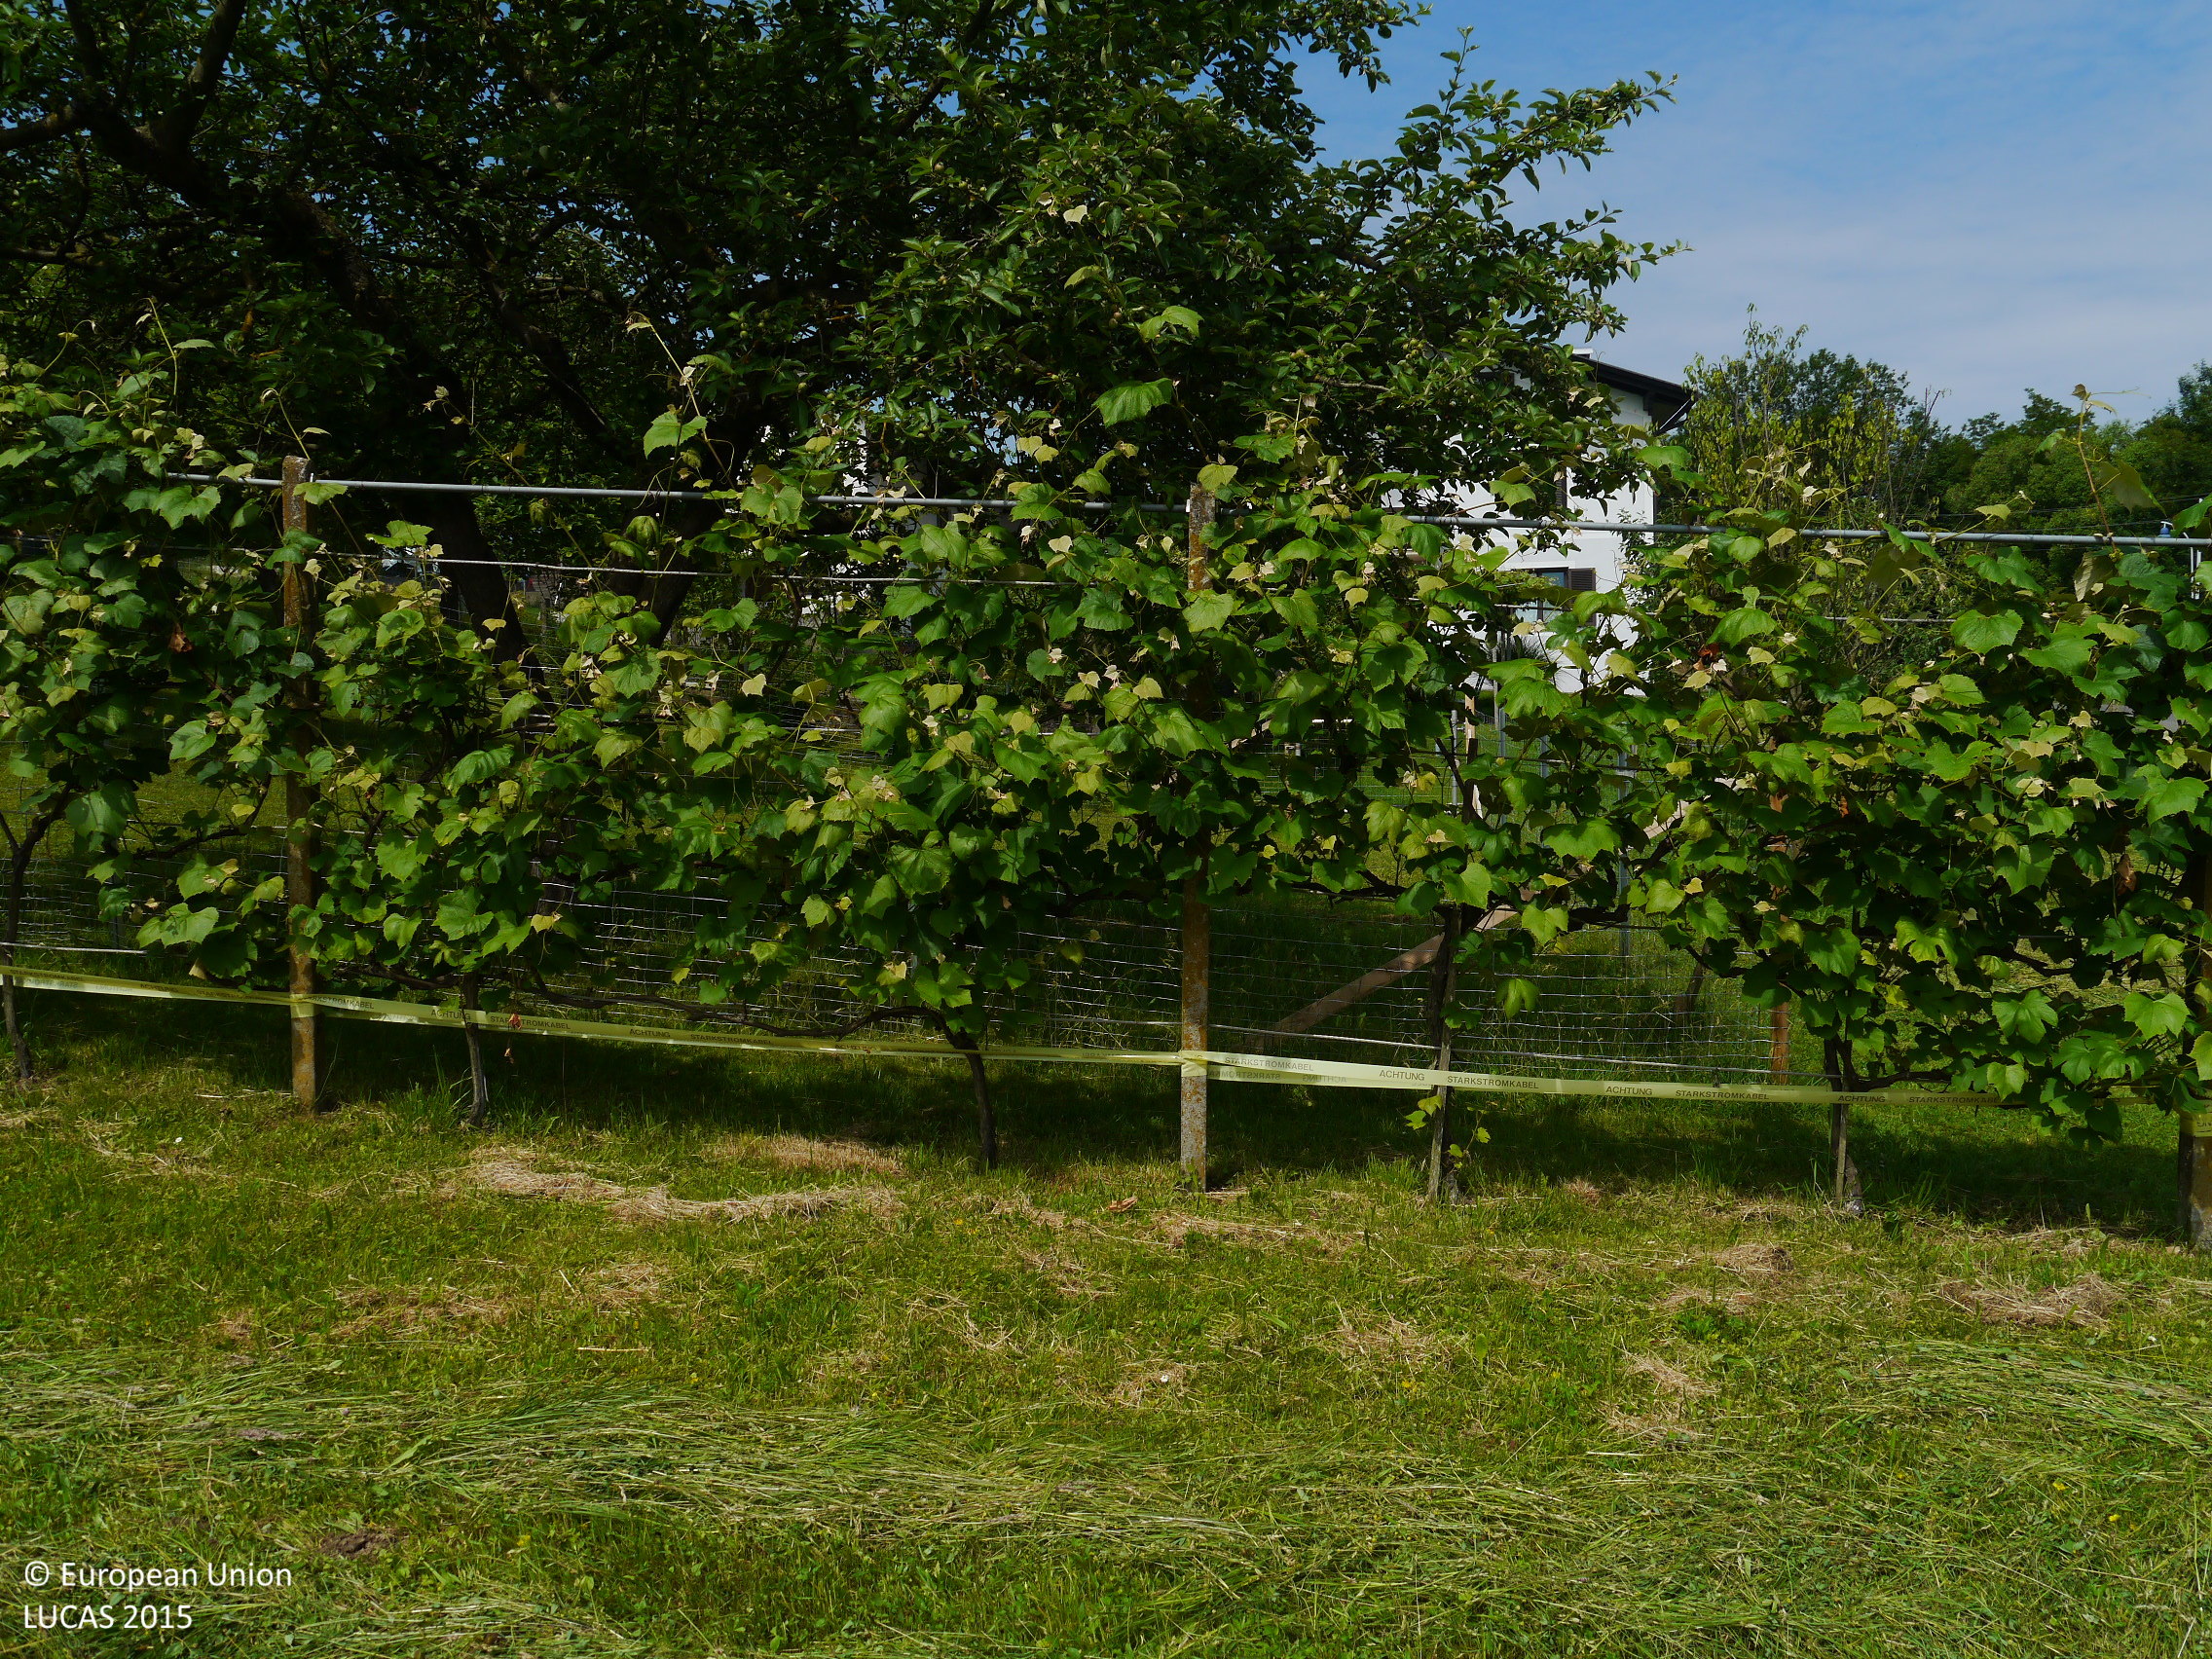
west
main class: Grassland
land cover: Grassland without tree/shrub cover
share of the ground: > 75 %
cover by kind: herbaceous plants 100 %
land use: Agriculture (excluding fallow land and kitchen gardens)
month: June
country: AT
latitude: 46.9027
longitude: 15.7105
